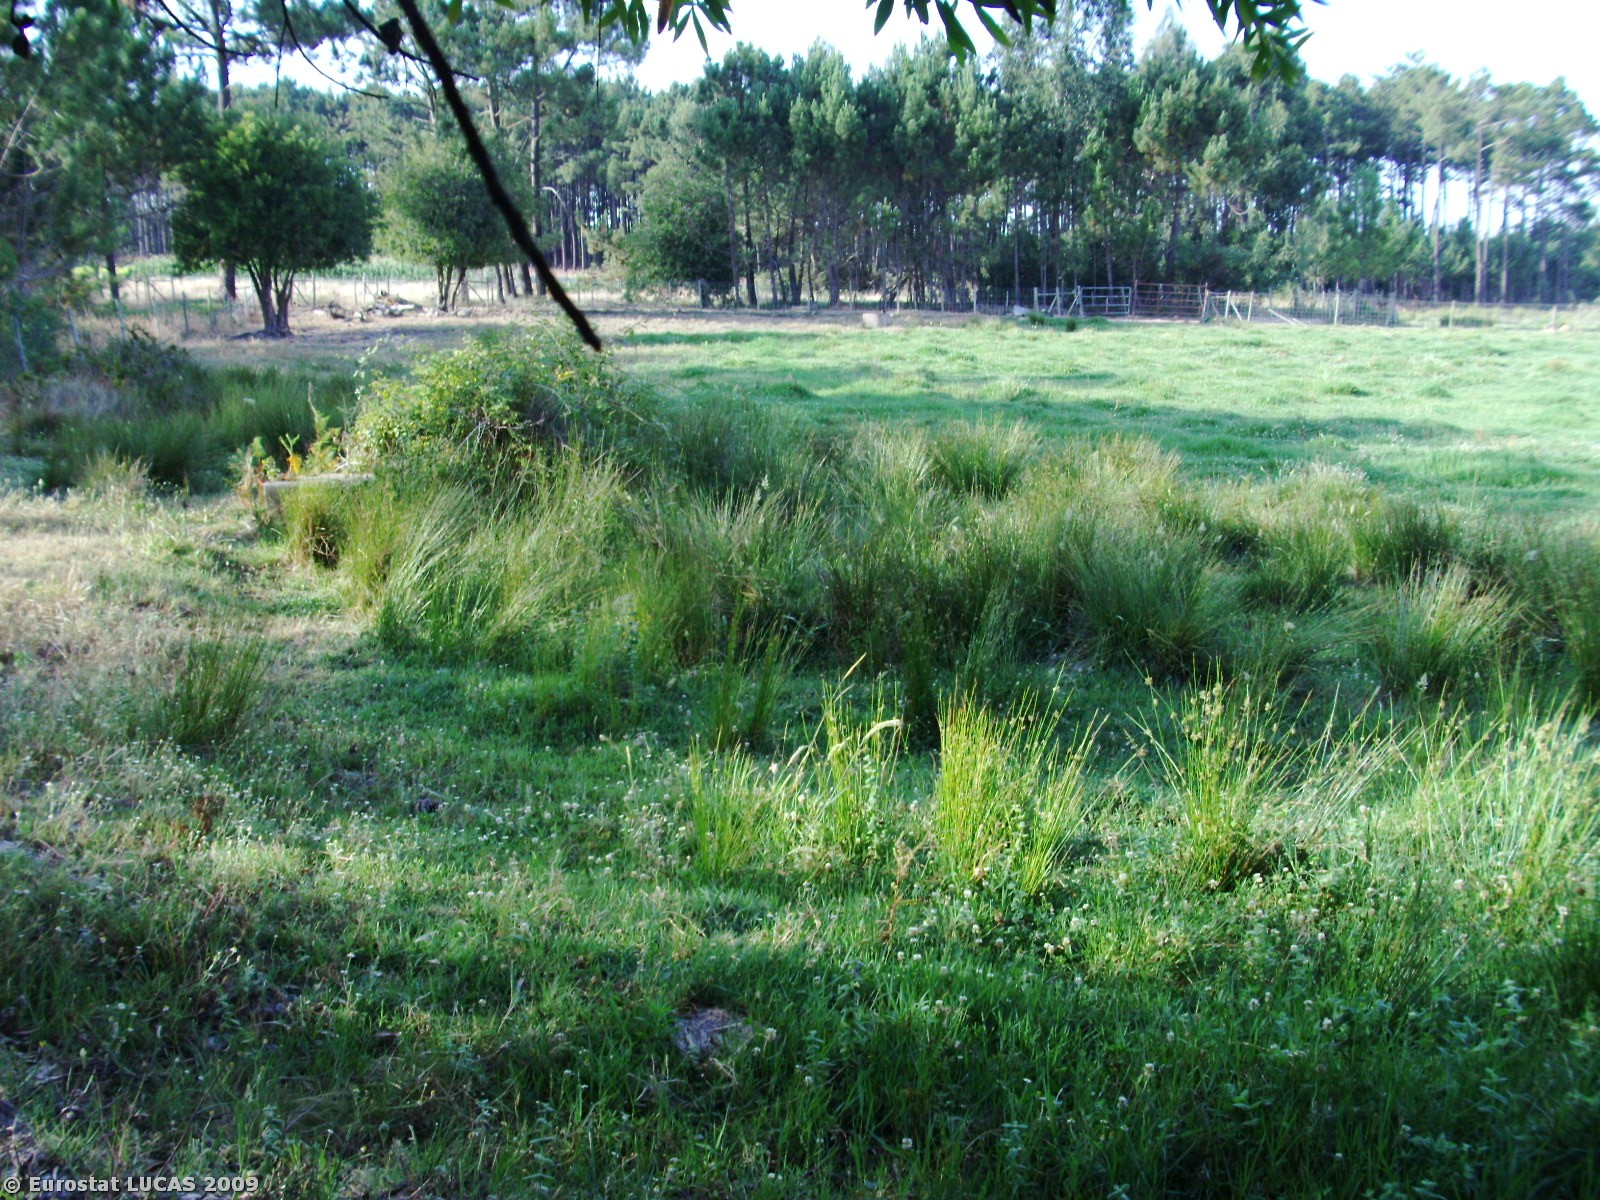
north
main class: Grassland
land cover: Grassland with sparse tree/shrub cover
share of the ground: > 75 %
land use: Agriculture (excluding fallow land and kitchen gardens)
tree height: > 5 m
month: June
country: PT
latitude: 37.3762
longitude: -8.7947
